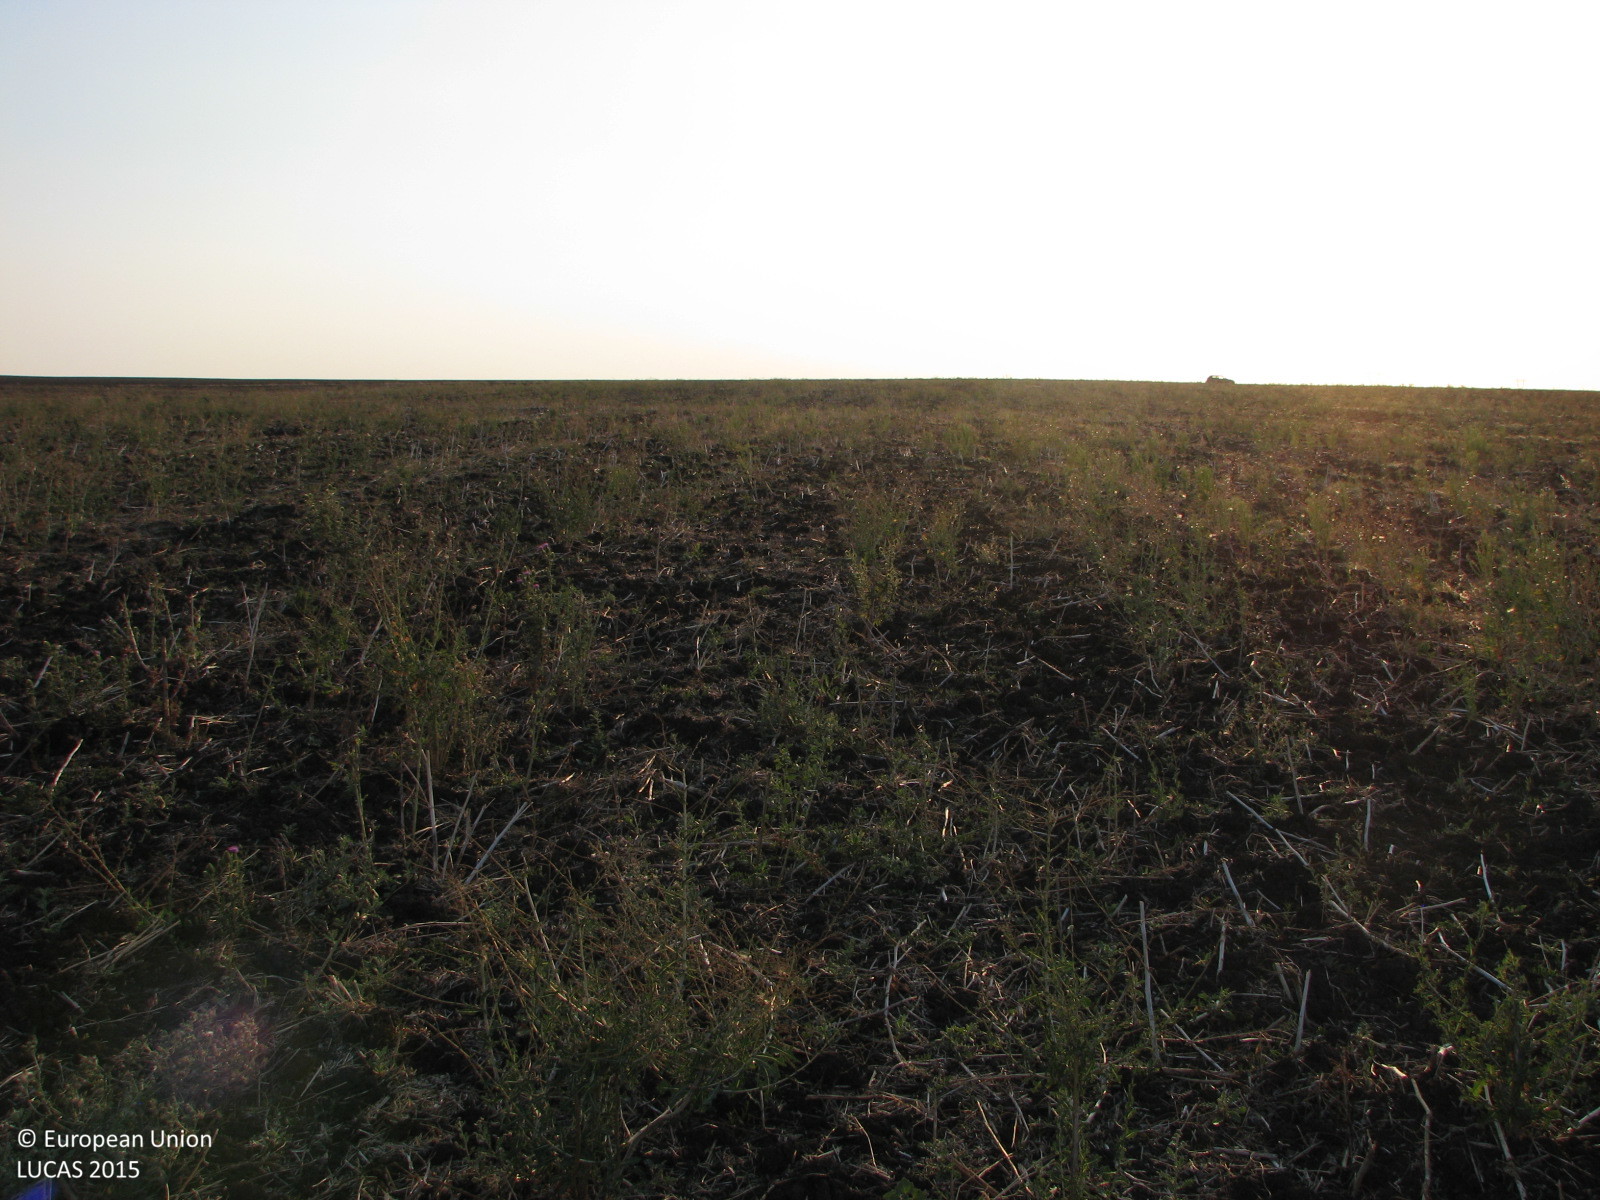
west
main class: Cropland
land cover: Barley
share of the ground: < 10 %
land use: Agriculture (excluding fallow land and kitchen gardens)
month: August
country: BG
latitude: 42.5002
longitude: 26.6326
